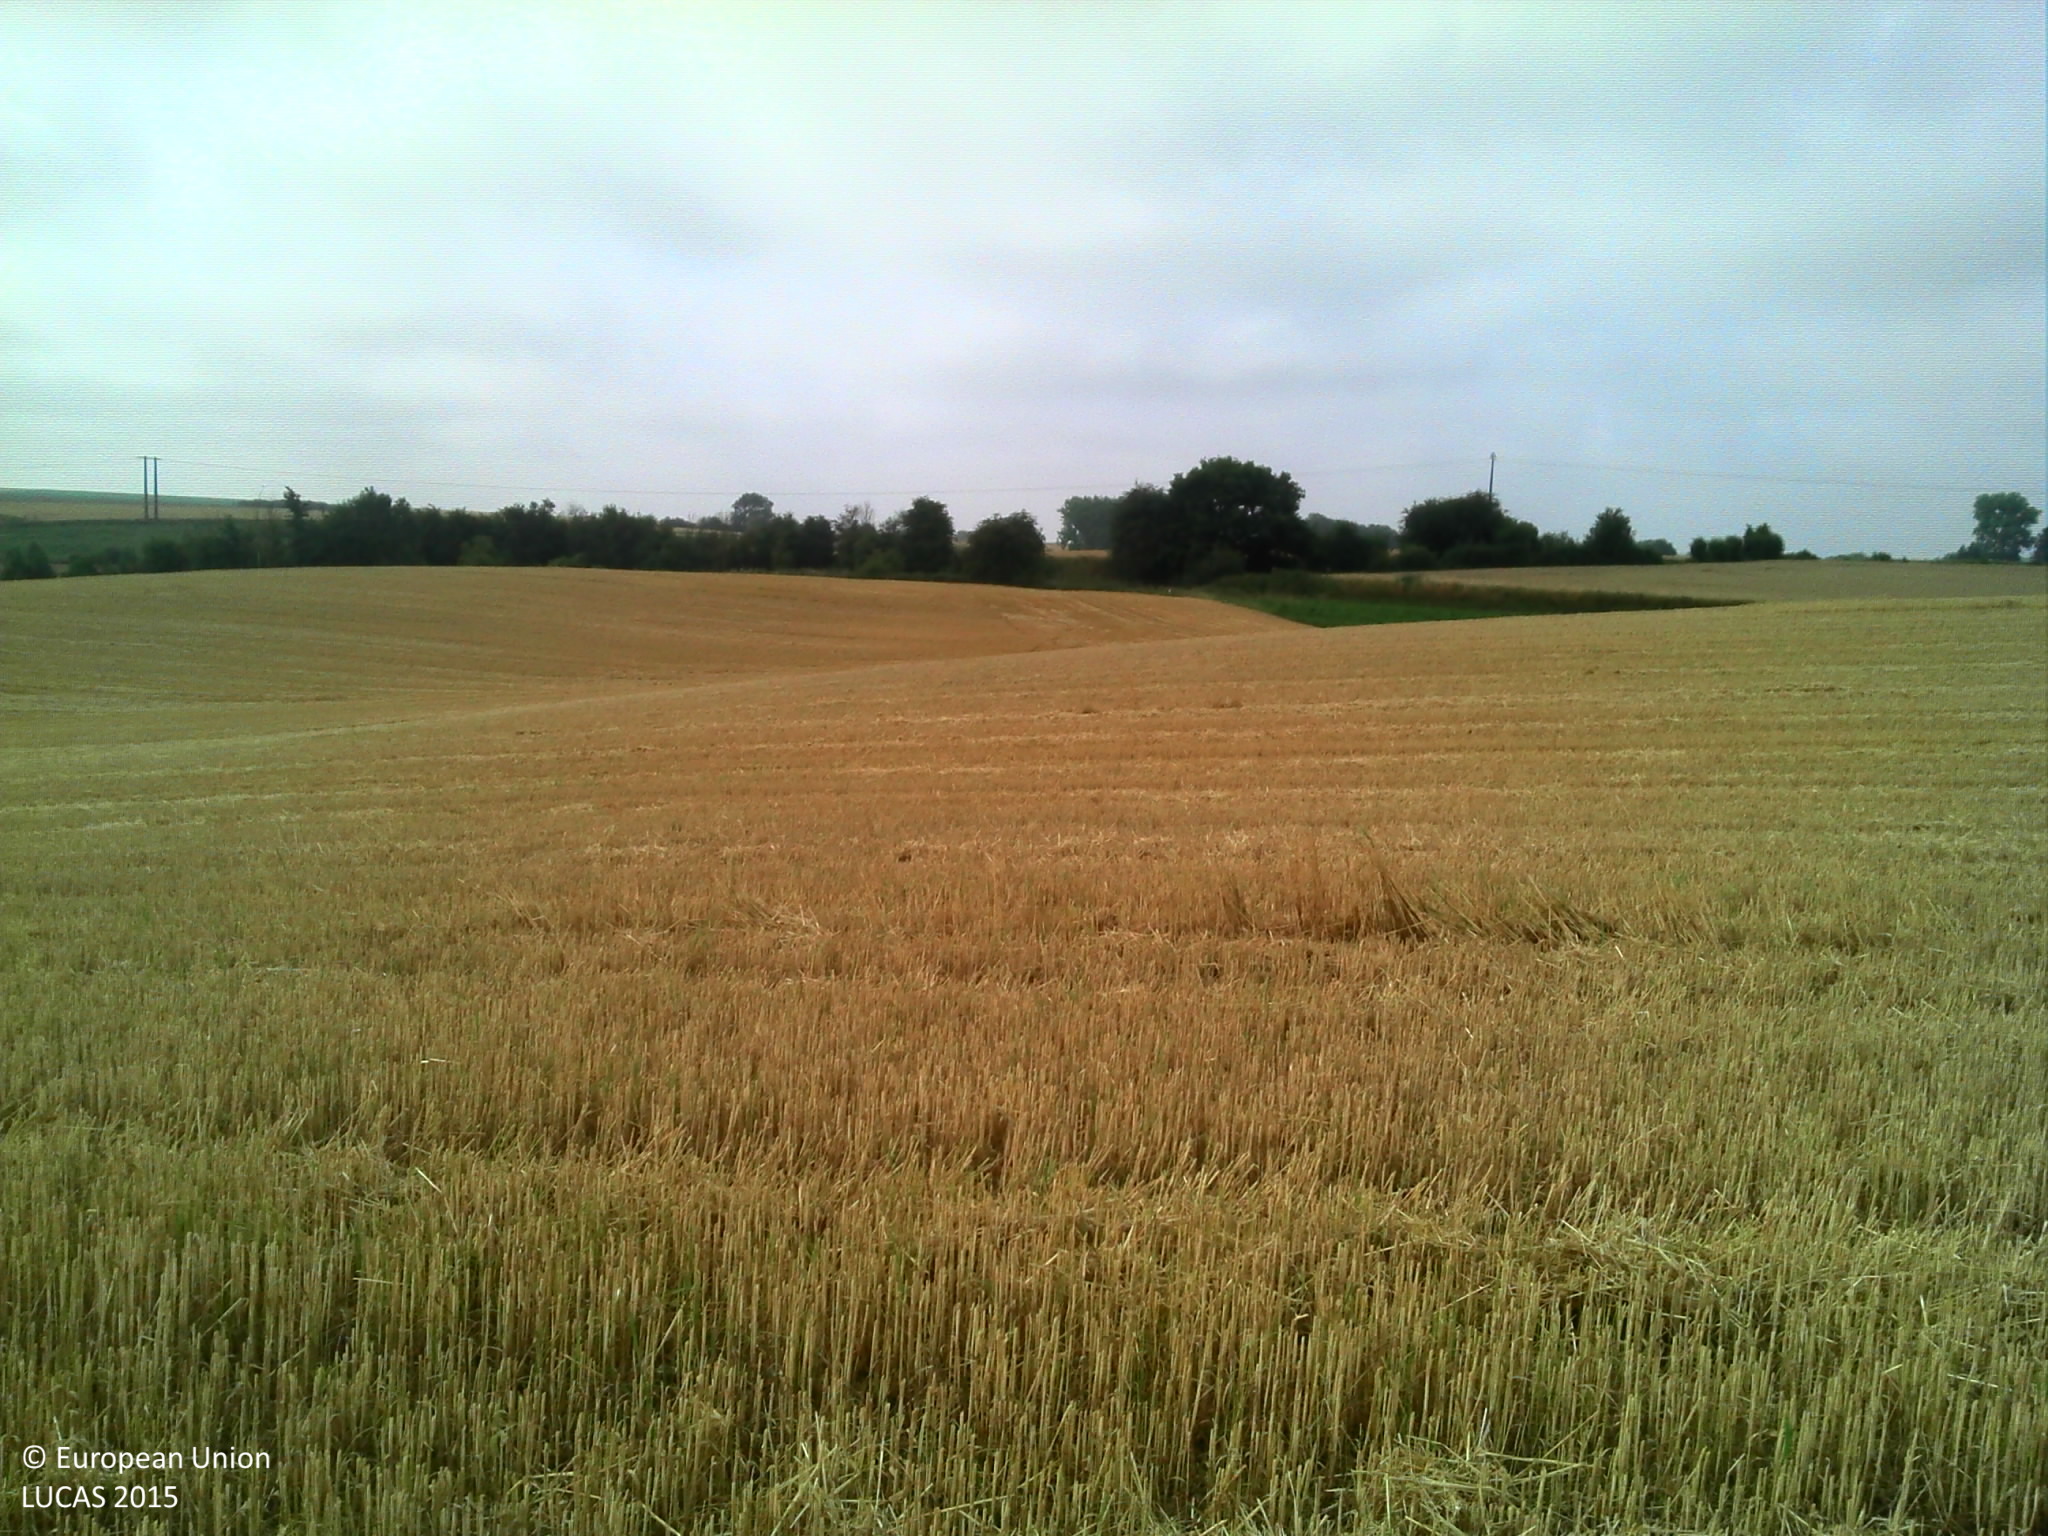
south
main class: Cropland
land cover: Barley
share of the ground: > 75 %
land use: Agriculture (excluding fallow land and kitchen gardens)
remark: Harvested field
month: July
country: FR
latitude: 50.0909
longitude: 2.3690
